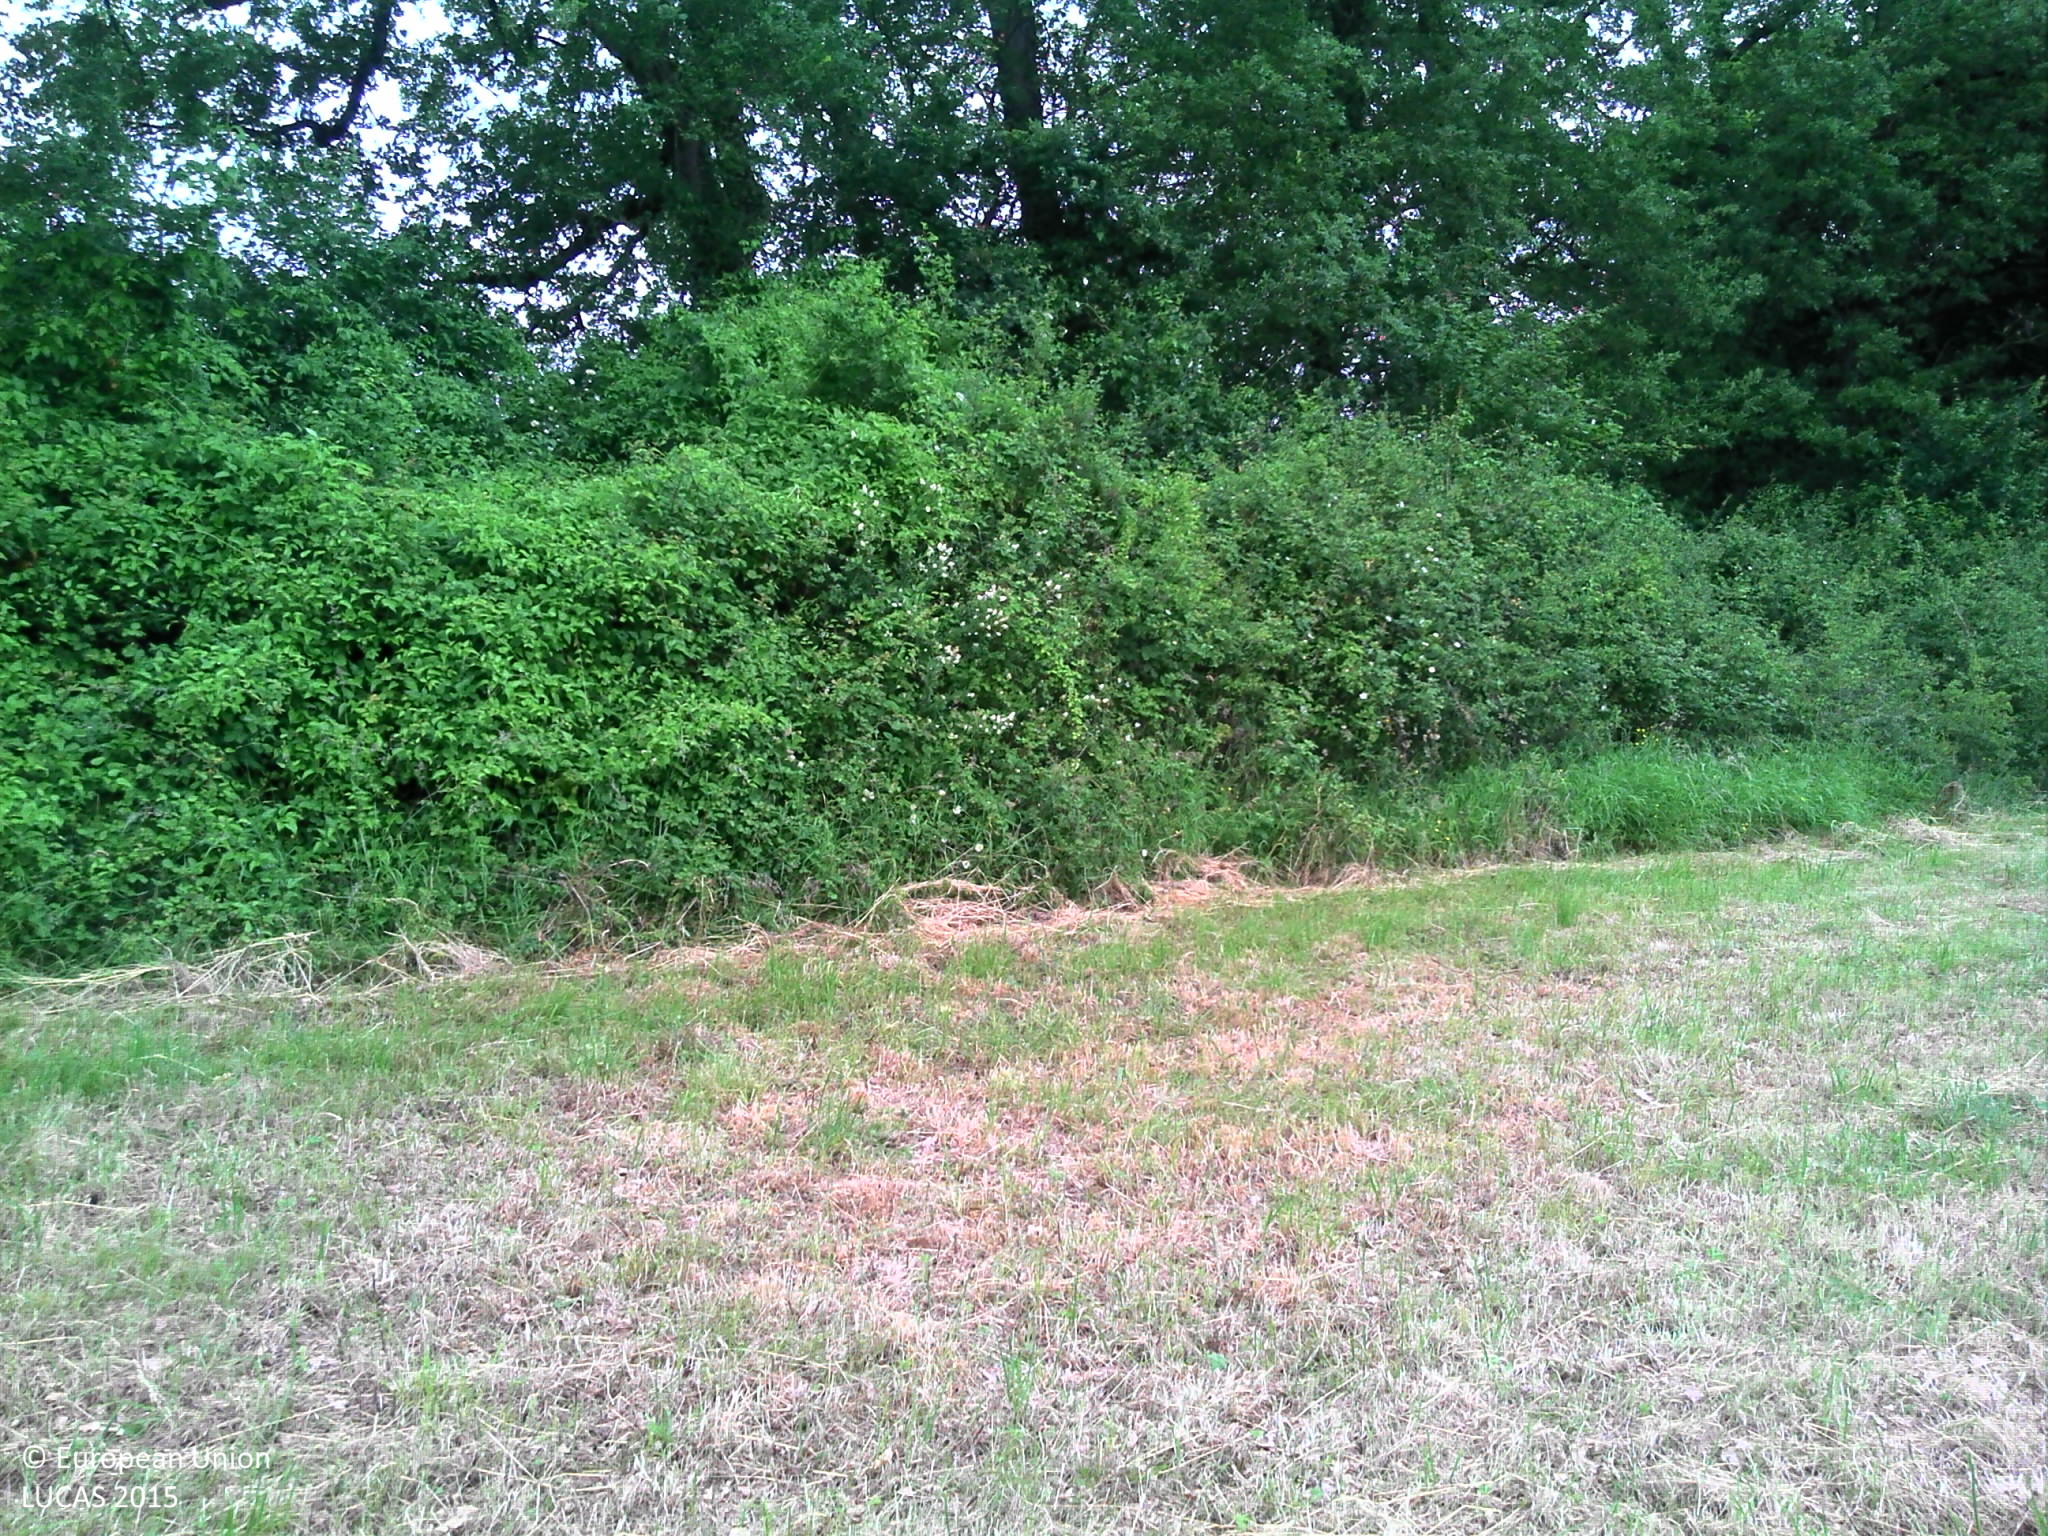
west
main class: Grassland
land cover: Grassland without tree/shrub cover
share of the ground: > 75 %
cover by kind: herbaceous plants 100 %
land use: Agriculture (excluding fallow land and kitchen gardens)
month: June
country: FR
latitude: 46.6984
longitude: 0.8167
